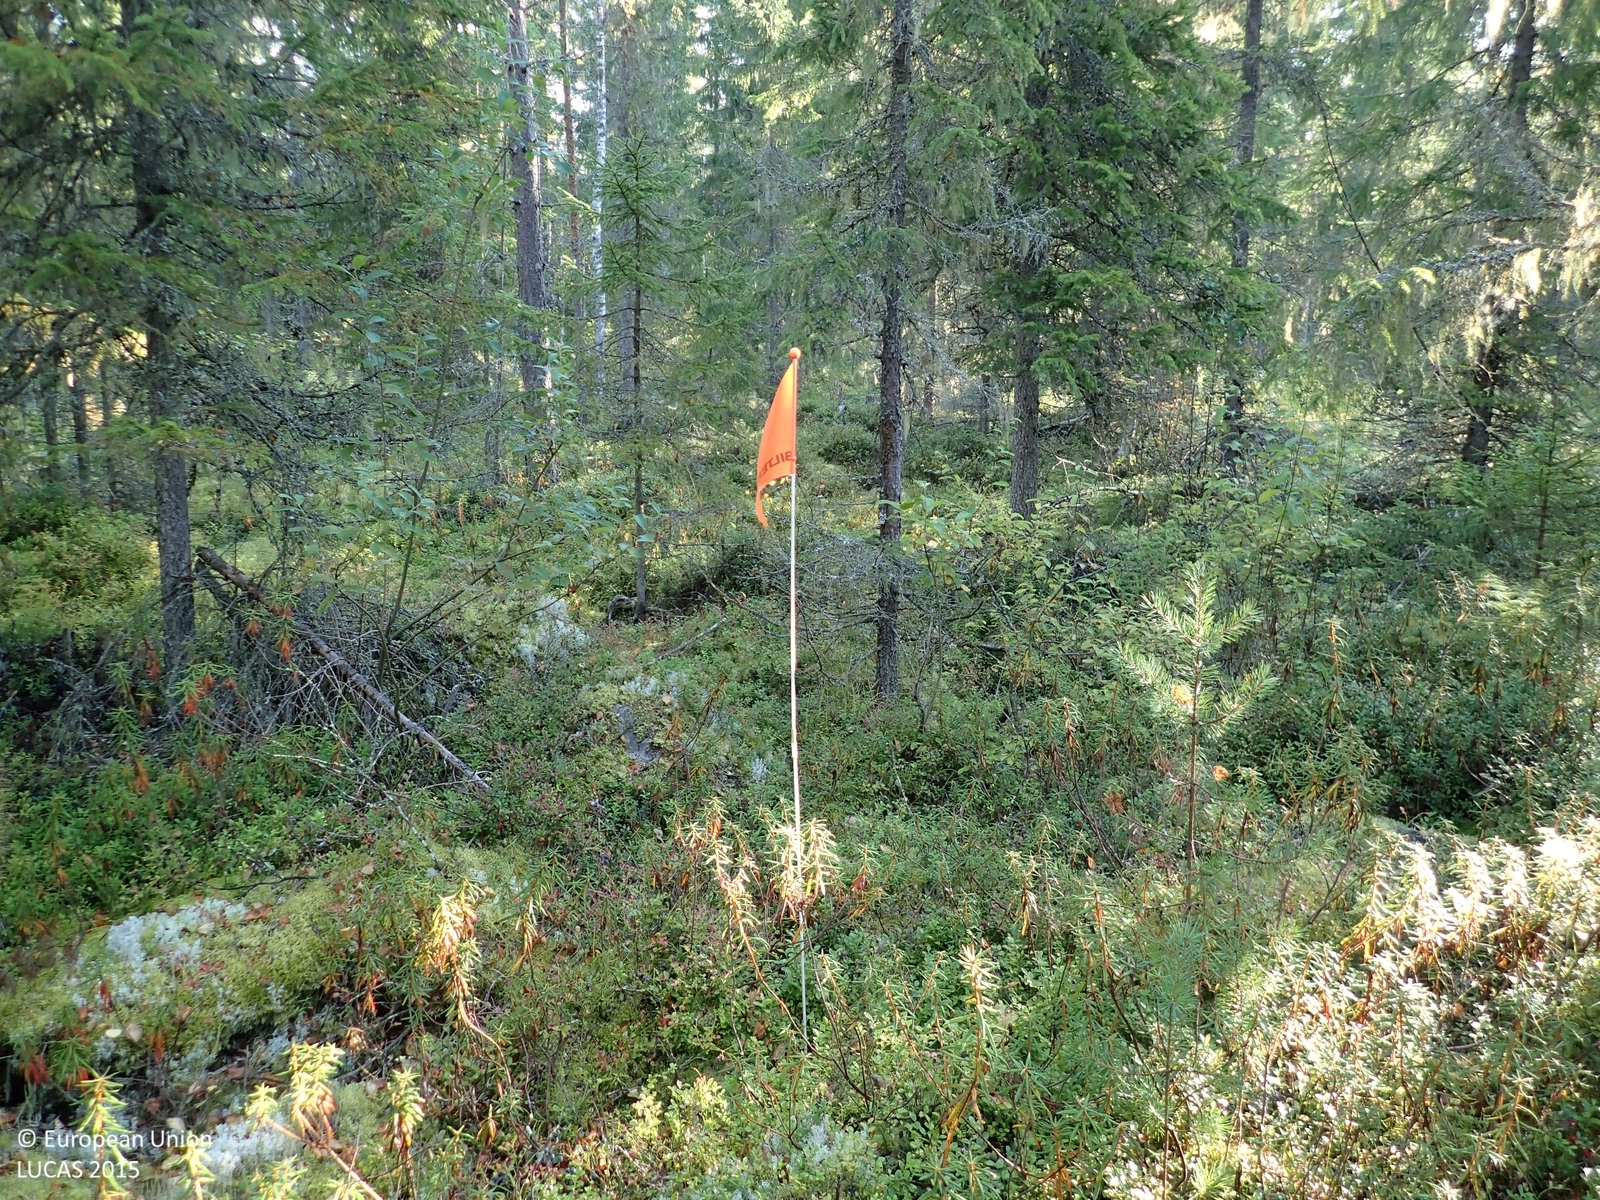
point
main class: Woodland
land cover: Spruce dominated coniferous woodland
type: boreal forest
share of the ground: > 75 %
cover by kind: coniferous forest trees 70 %, shrubs 15 %, broadleaved forest trees 5 %, herbaceous plants 5 %, lichens and mosses 5 %
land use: Forestry
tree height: > 5 m
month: September
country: FI
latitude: 63.0887
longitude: 25.3715
